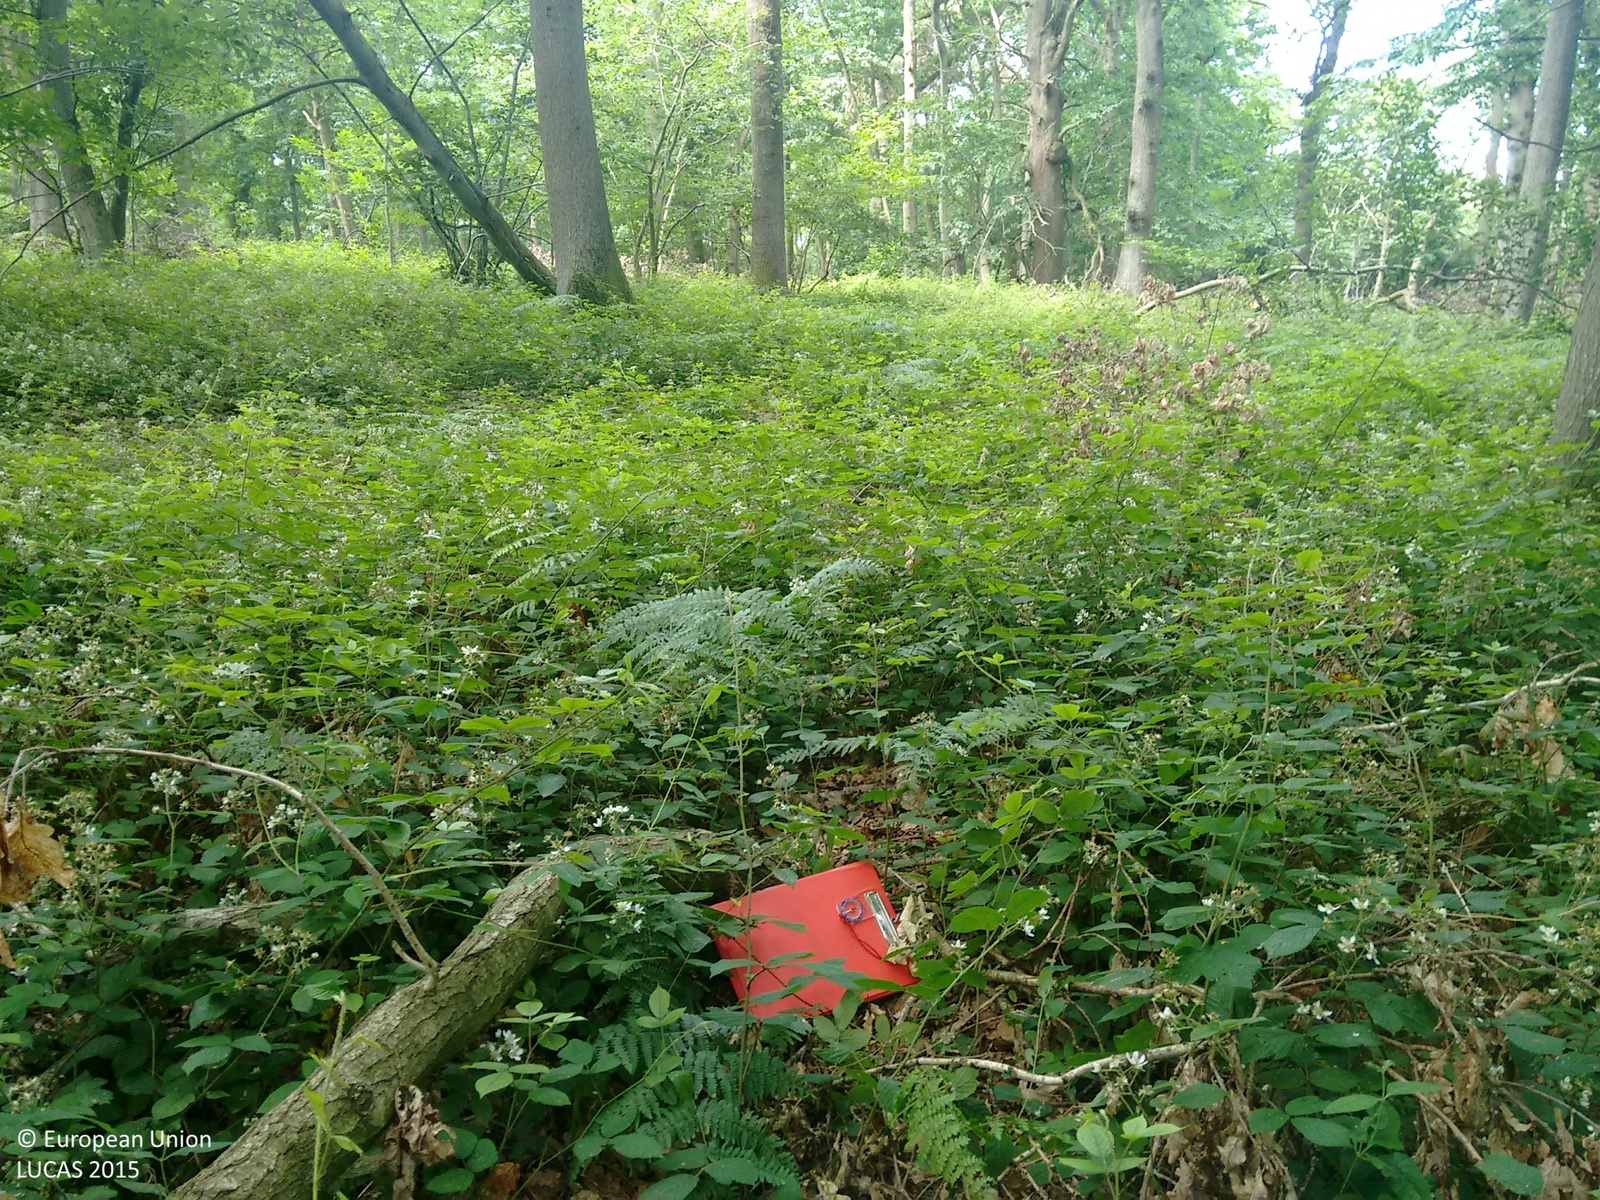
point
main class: Woodland
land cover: Broadleaved woodland
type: mesophytic deciduous forest
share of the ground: > 75 %
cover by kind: broadleaved forest trees 95 %, shrubs 5 %
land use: Semi-natural and natural areas not in use
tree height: > 5 m
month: July
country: GB
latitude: 52.1636
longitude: -2.7157
